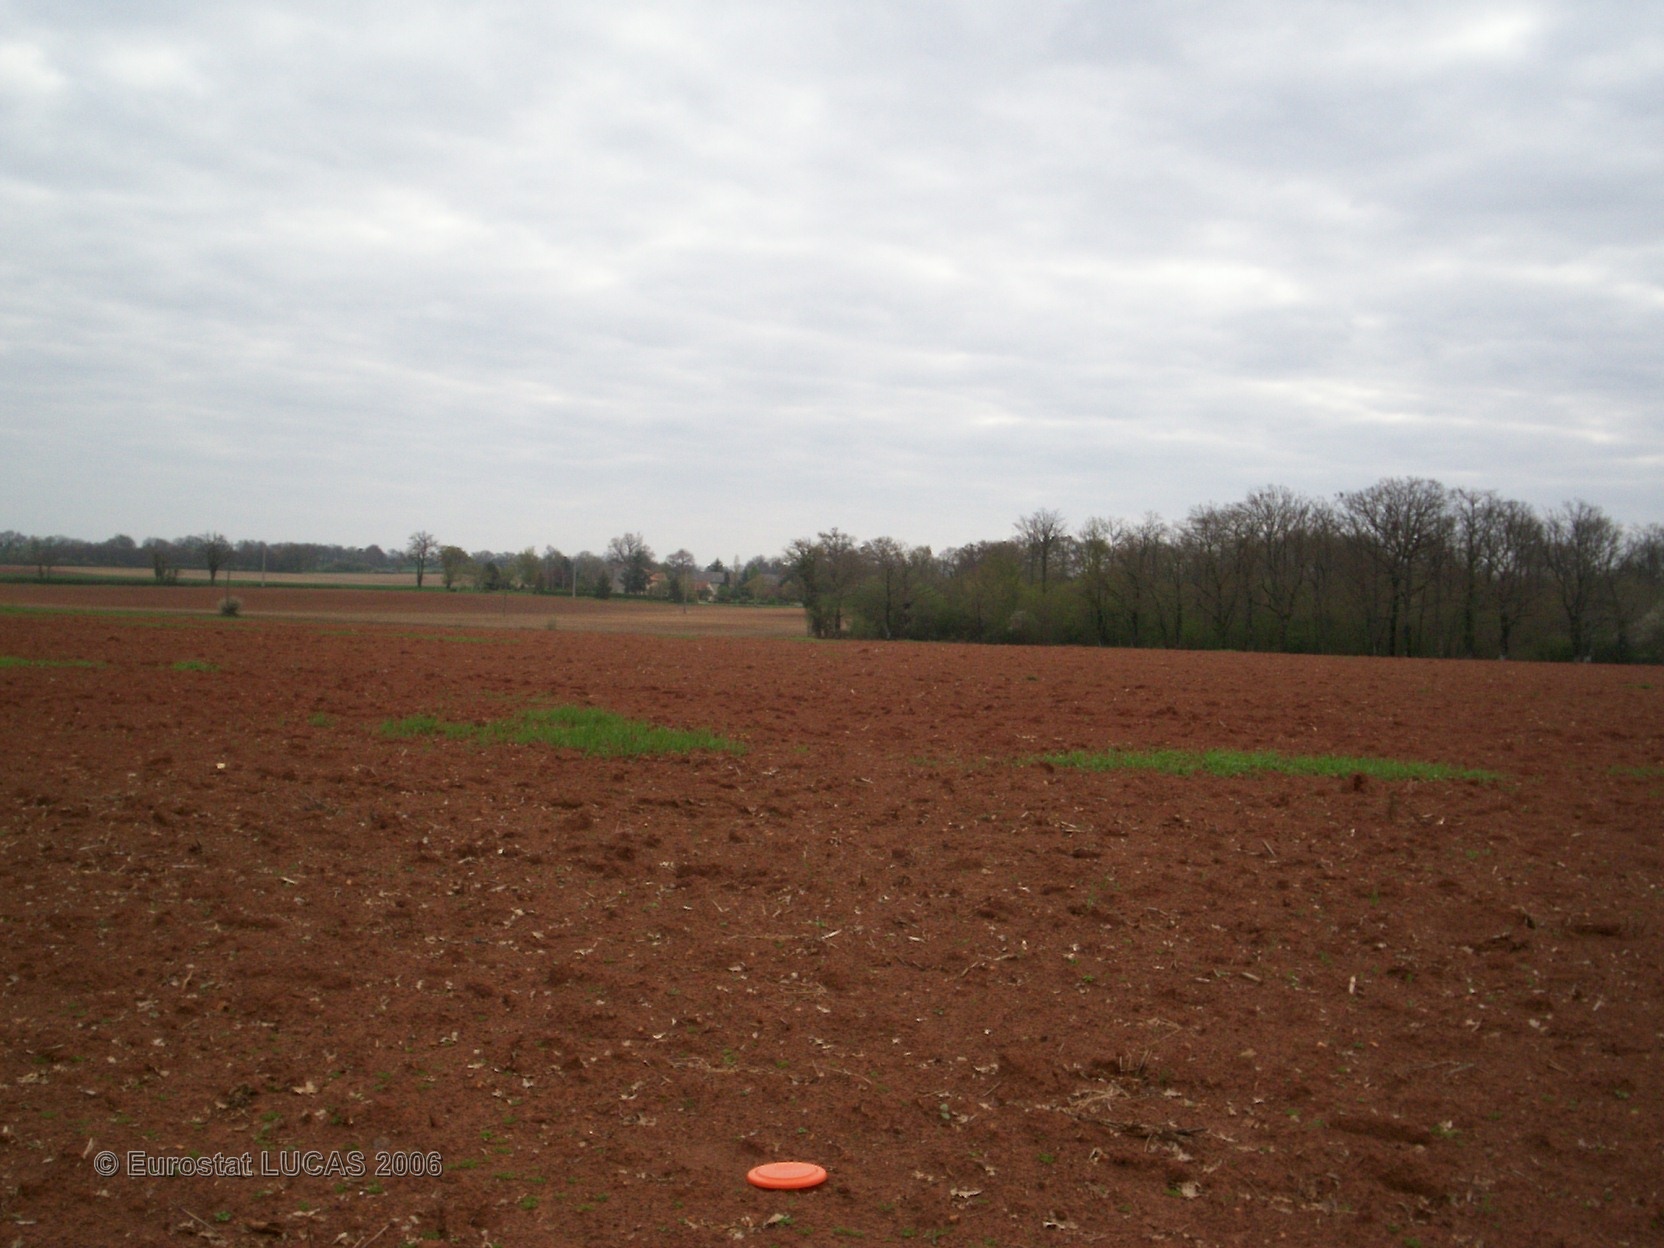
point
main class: Cropland
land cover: Maize
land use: Agriculture (excluding fallow land and kitchen gardens)
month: May
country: FR
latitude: 46.1313
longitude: 0.5490
